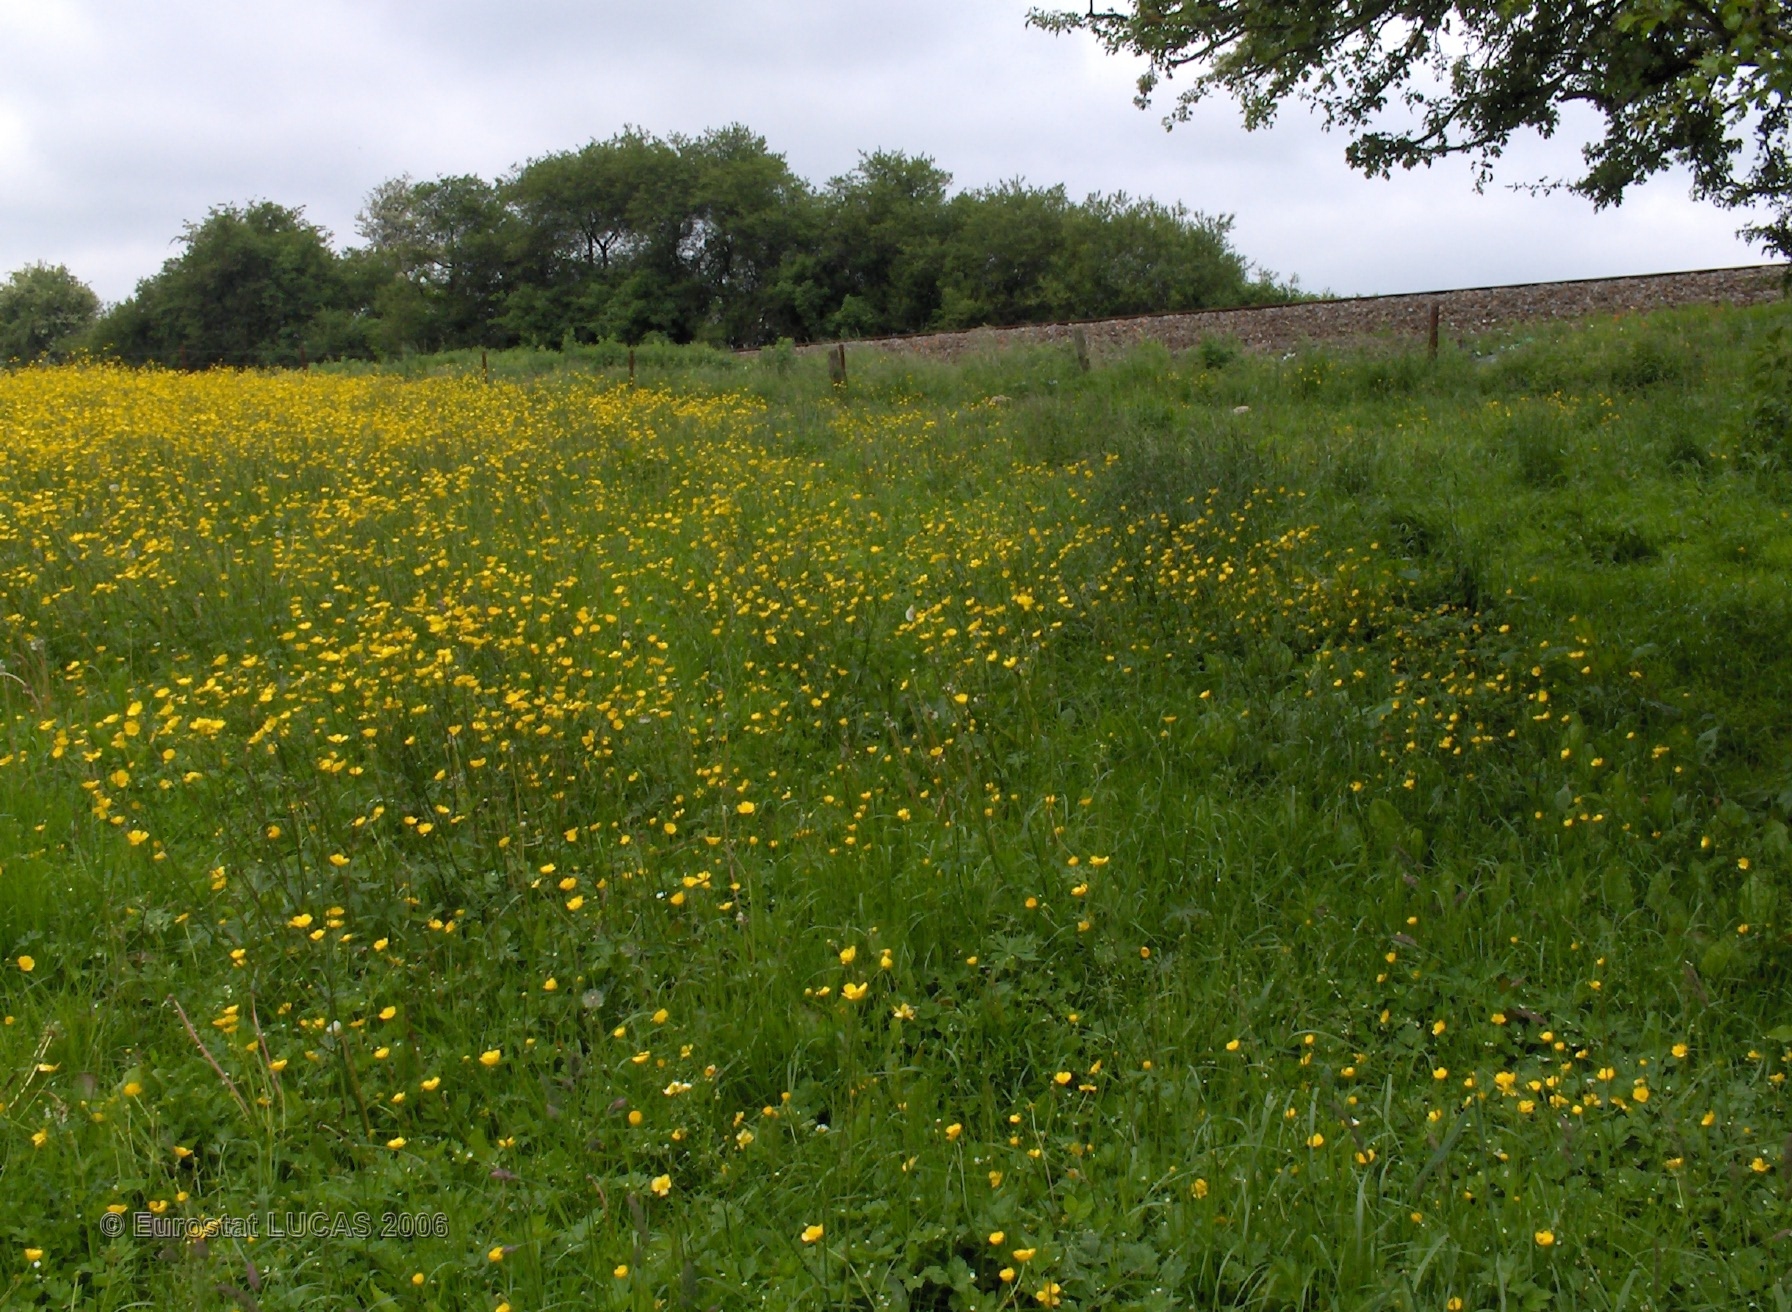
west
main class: Grassland
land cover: Grassland without tree/shrub cover
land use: Agriculture (excluding fallow land and kitchen gardens)
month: June
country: BE
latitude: 50.1787
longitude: 4.5207
